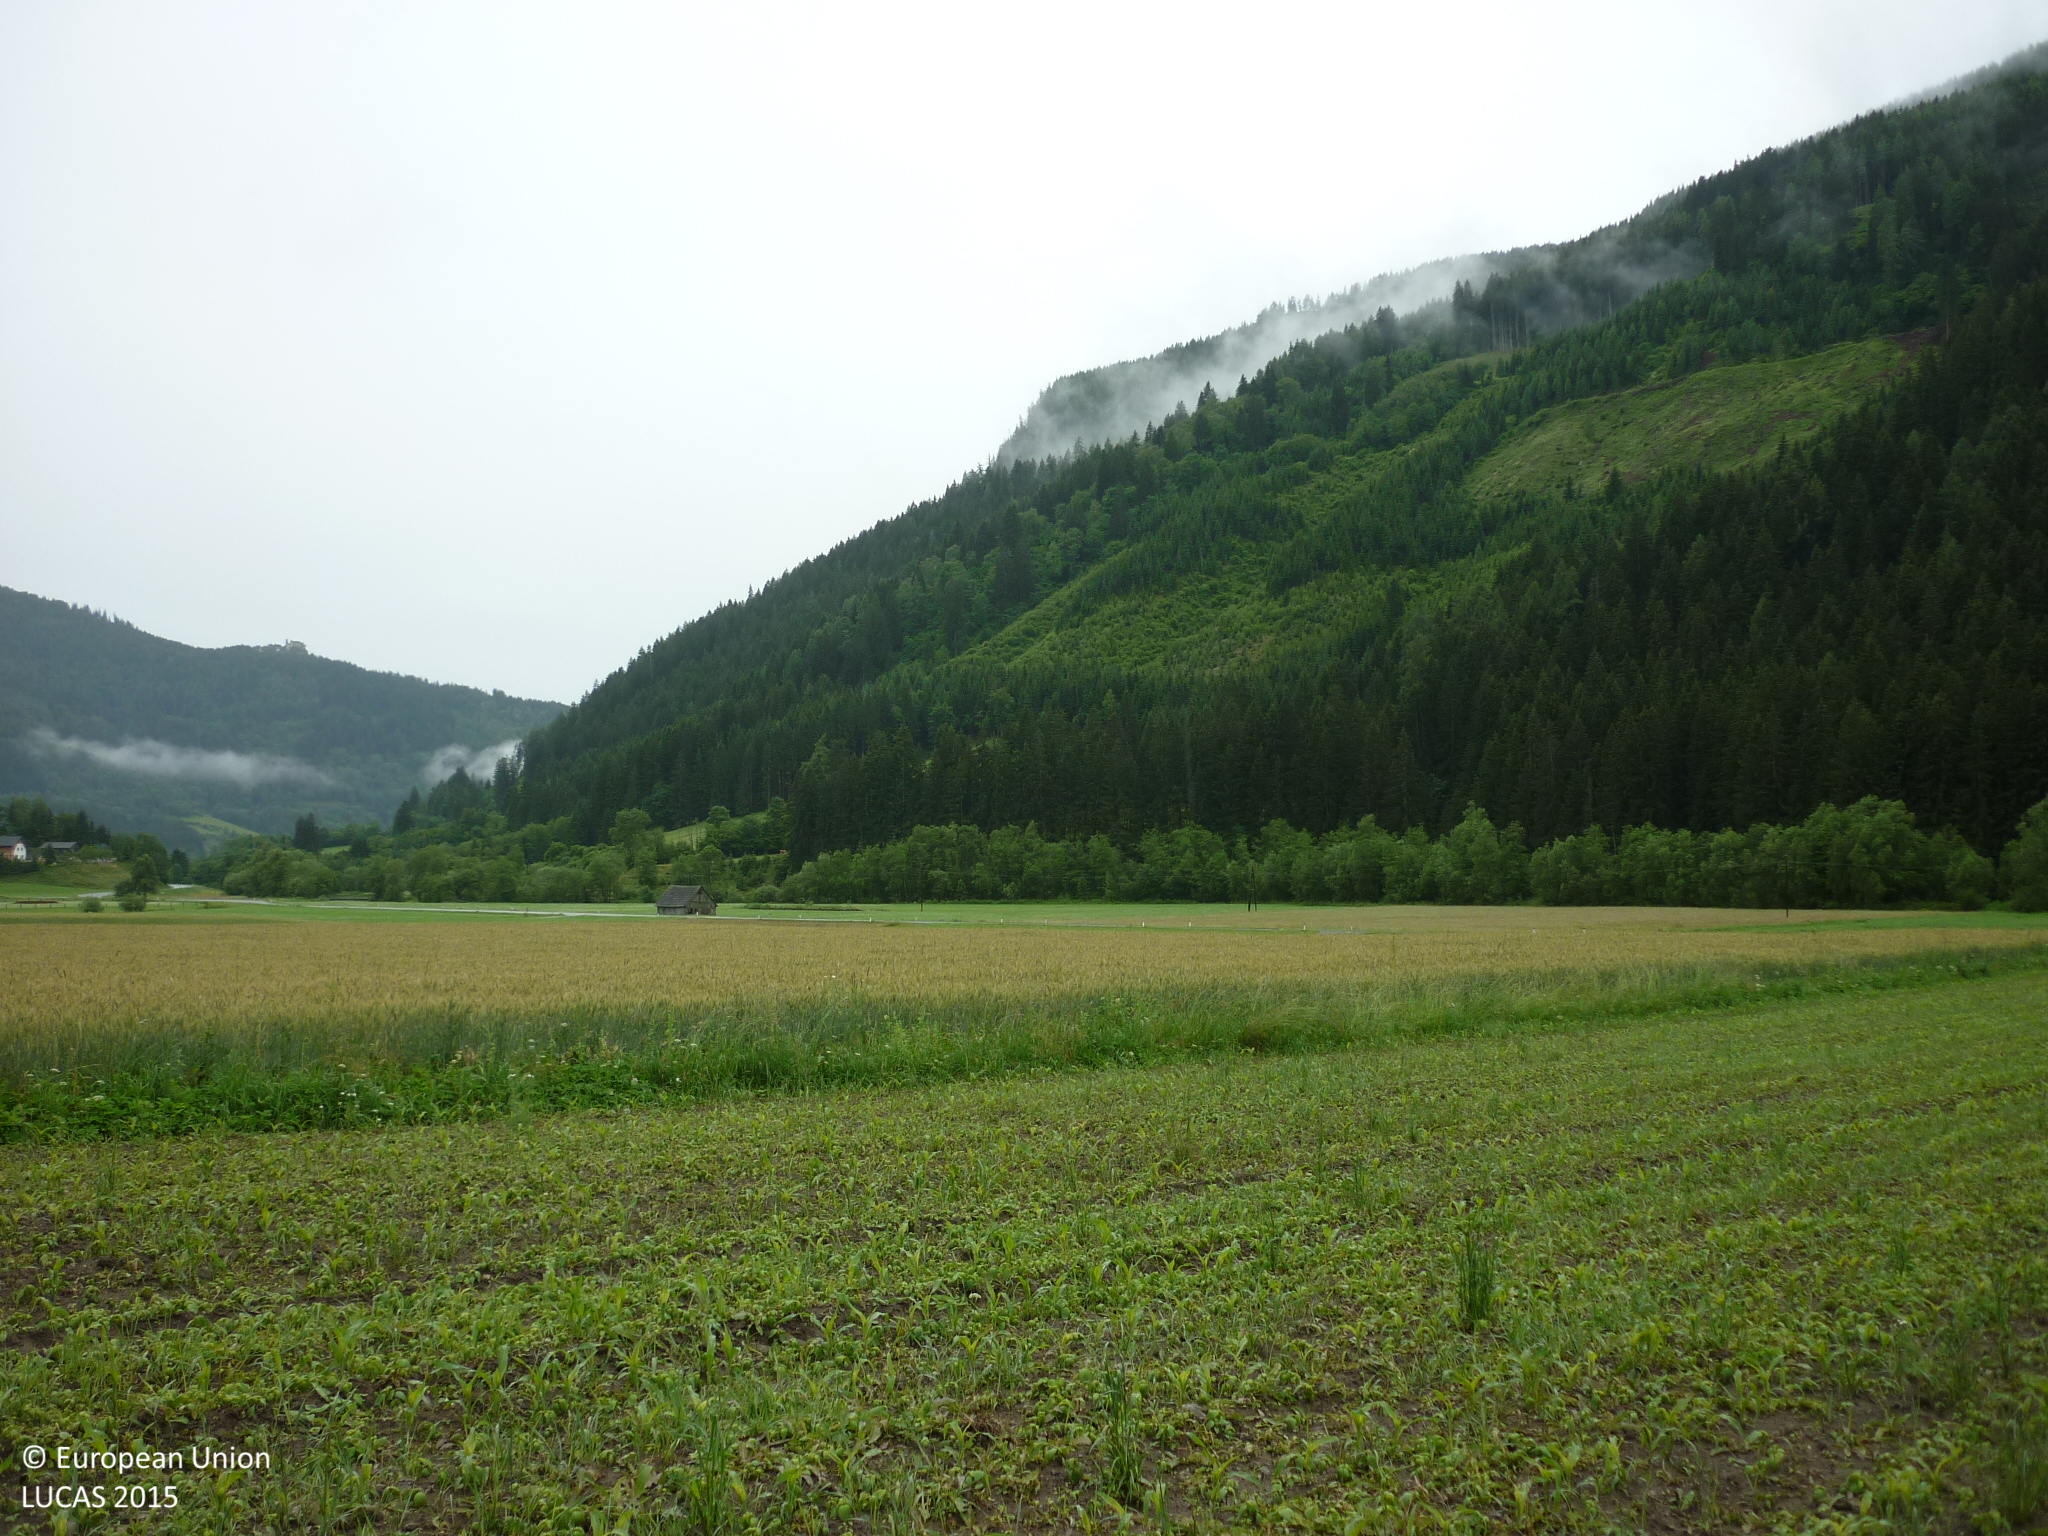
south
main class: Cropland
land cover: Maize
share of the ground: 25 - 50 %
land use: Agriculture (excluding fallow land and kitchen gardens)
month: June
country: AT
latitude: 47.1638
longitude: 14.3648
